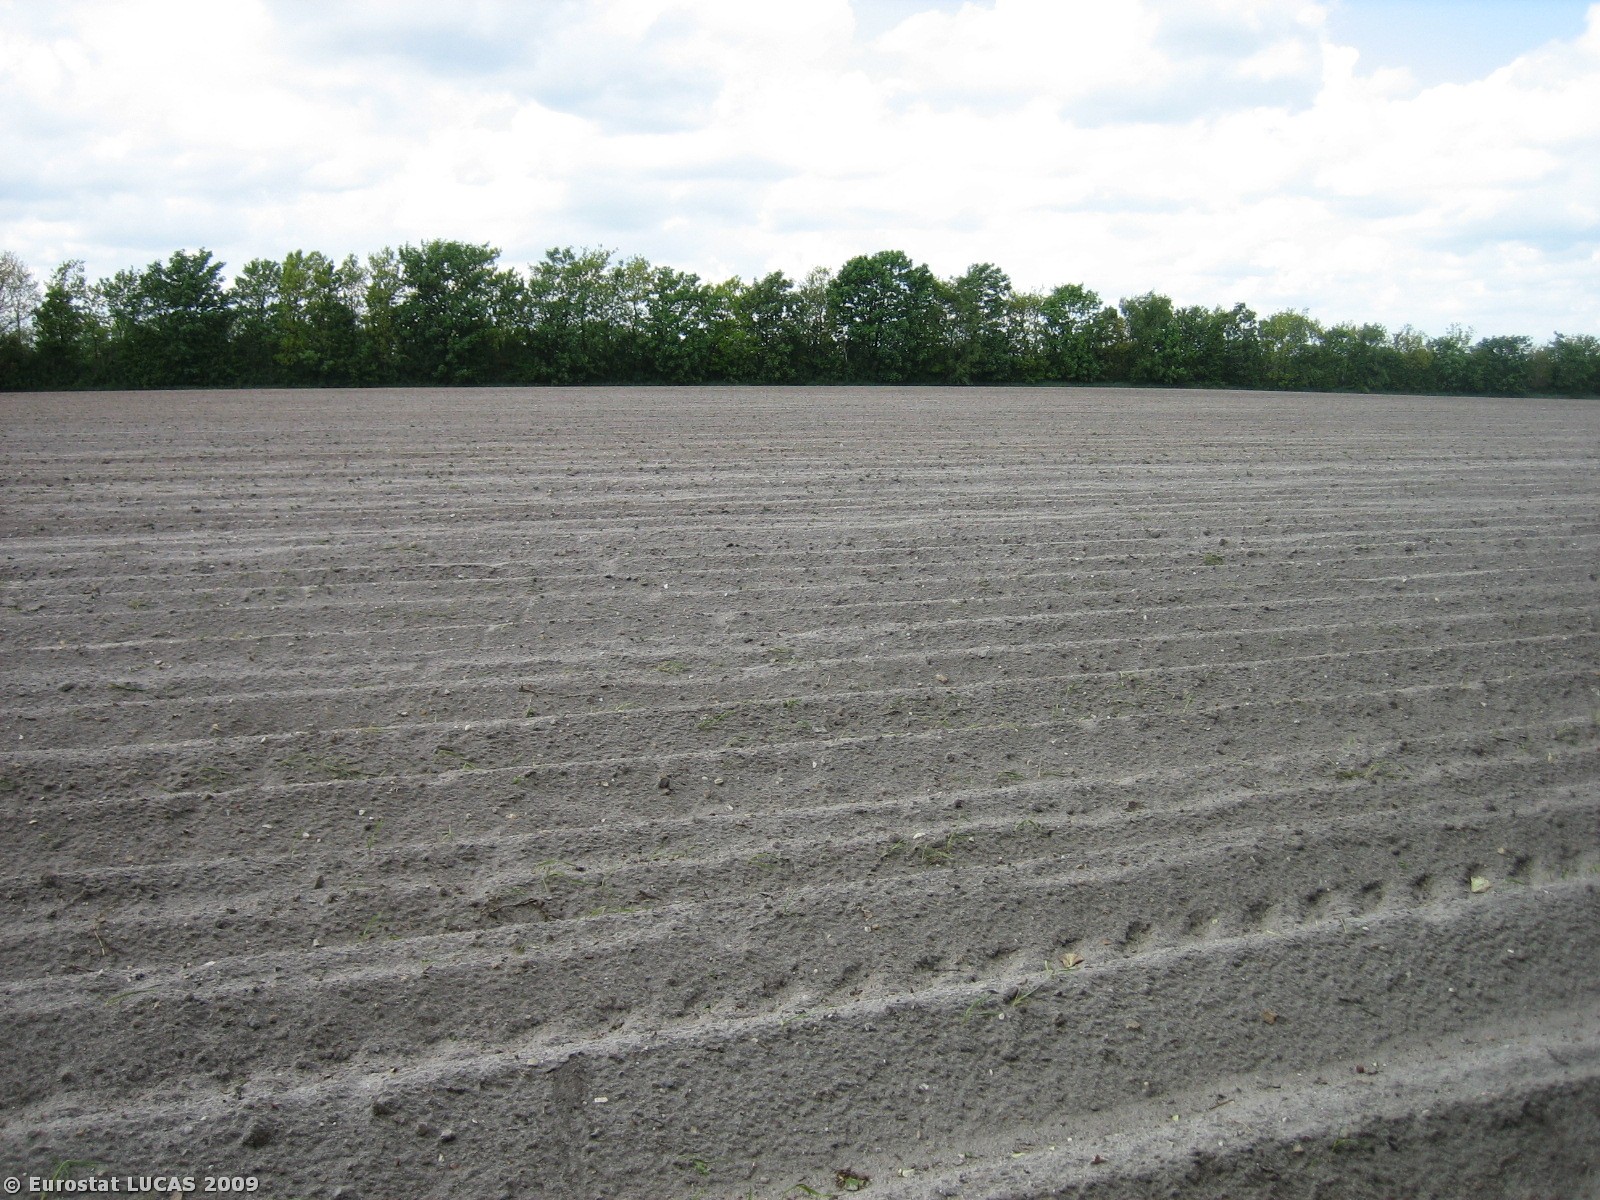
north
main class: Woodland
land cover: Broadleaved woodland
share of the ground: > 75 %
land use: Unused
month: May
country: DK
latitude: 56.2911
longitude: 8.9188
